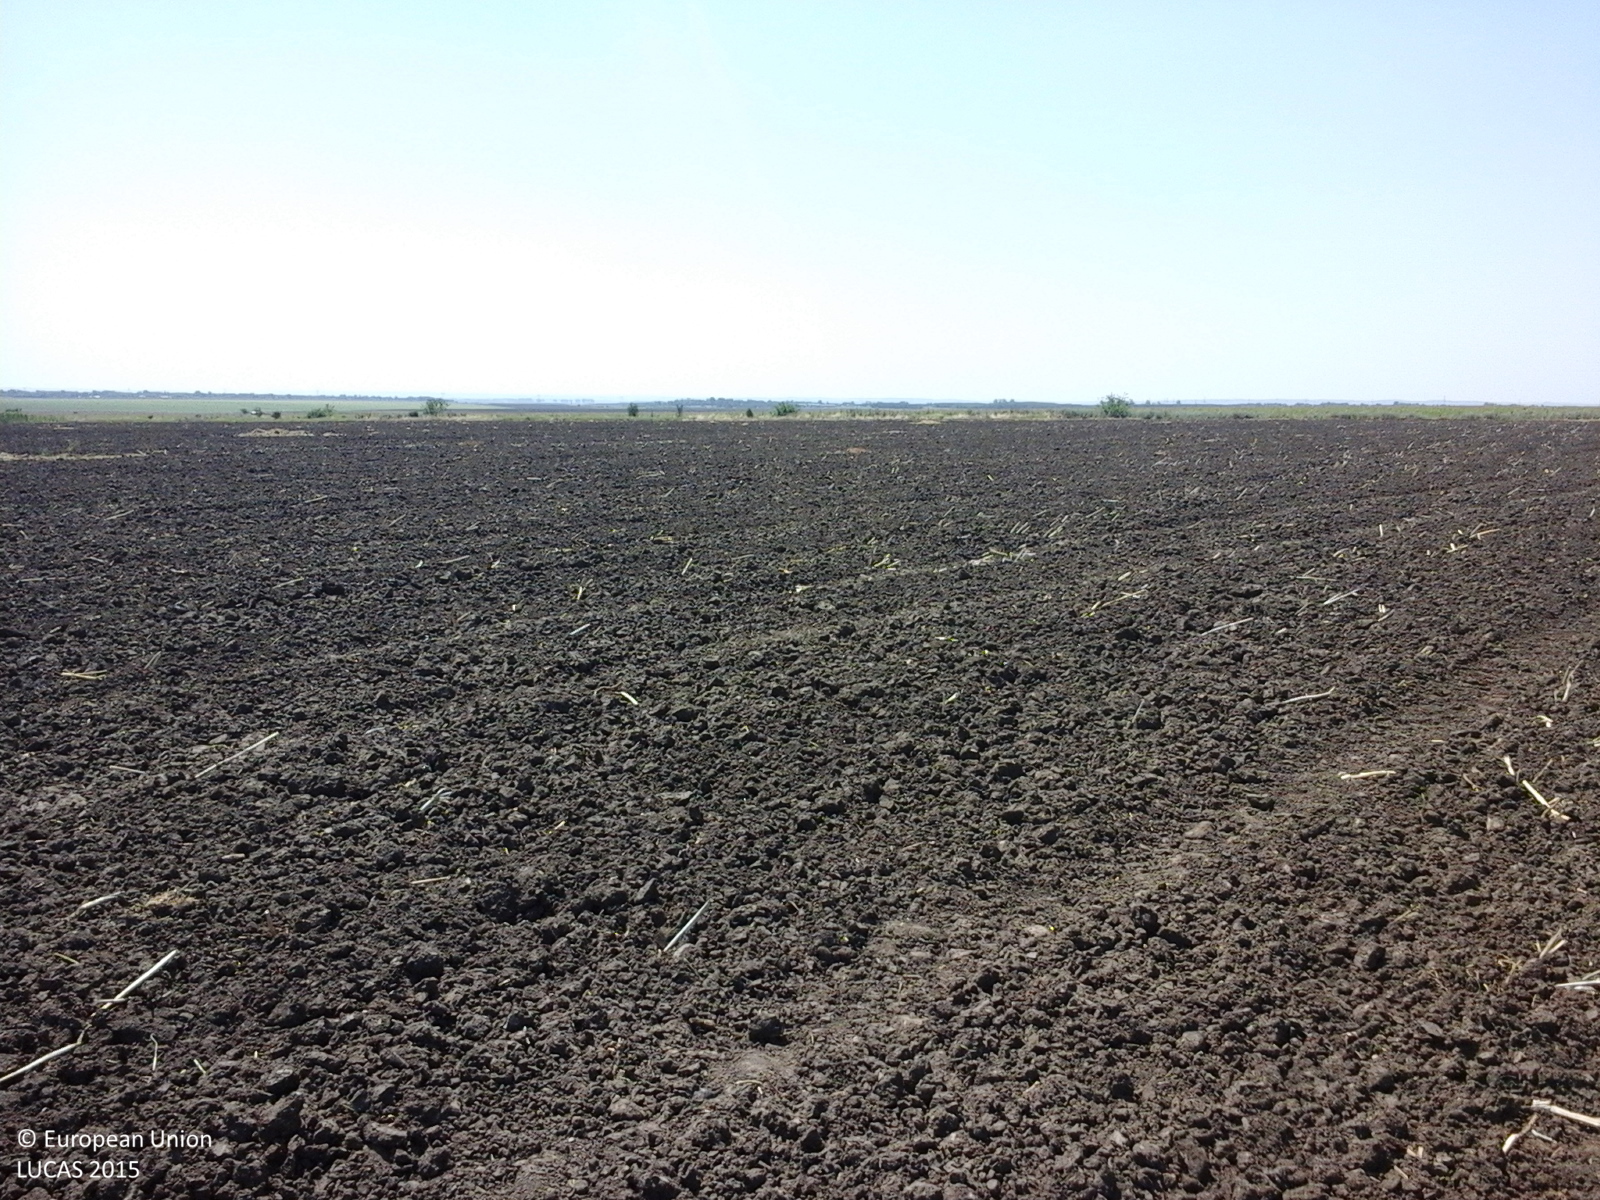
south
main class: Cropland
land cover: Rape and turnip rape
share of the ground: < 10 %
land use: Agriculture (excluding fallow land and kitchen gardens)
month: July
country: RO
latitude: 44.2965
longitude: 27.1125
